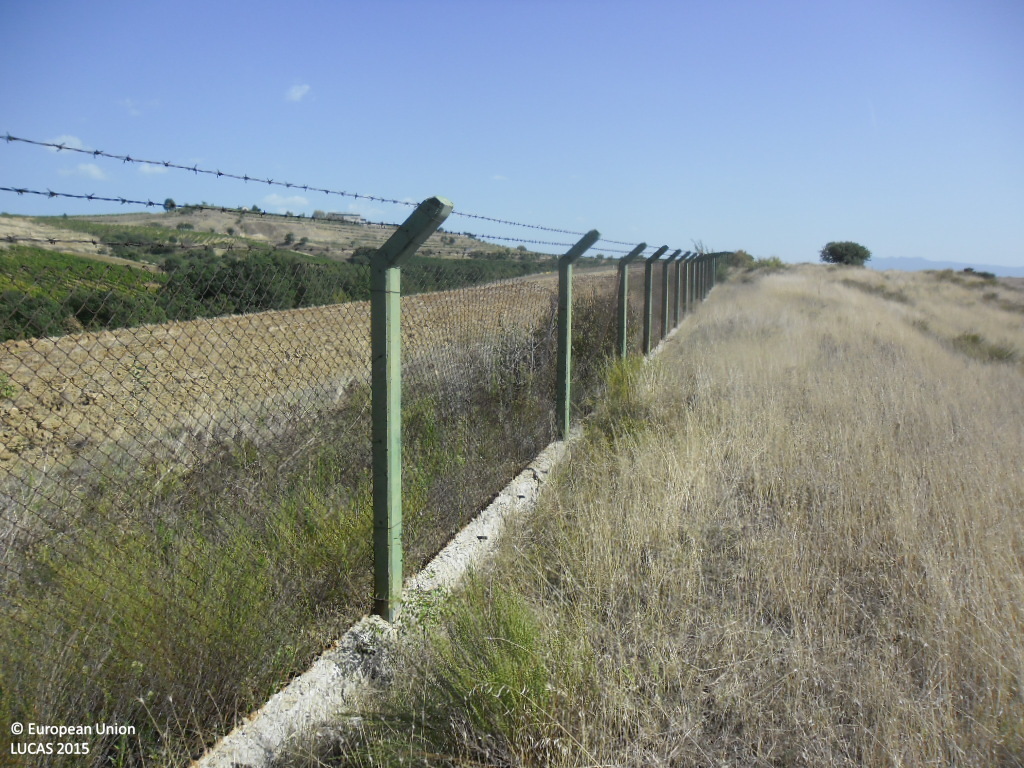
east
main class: Grassland
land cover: Spontaneously vegetated surfaces
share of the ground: 25 - 50 %
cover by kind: herbaceous plants 90 %, unconsolidated bare surface 10 %
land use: Agriculture (excluding fallow land and kitchen gardens)
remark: Harvested field
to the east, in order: Spontaneously vegetated surfaces; Broadleaved woodland; Grassland without tree/shrub cover; Broadleaved woodland; Vineyards
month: September
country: BG
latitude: 41.4911
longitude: 23.3534
